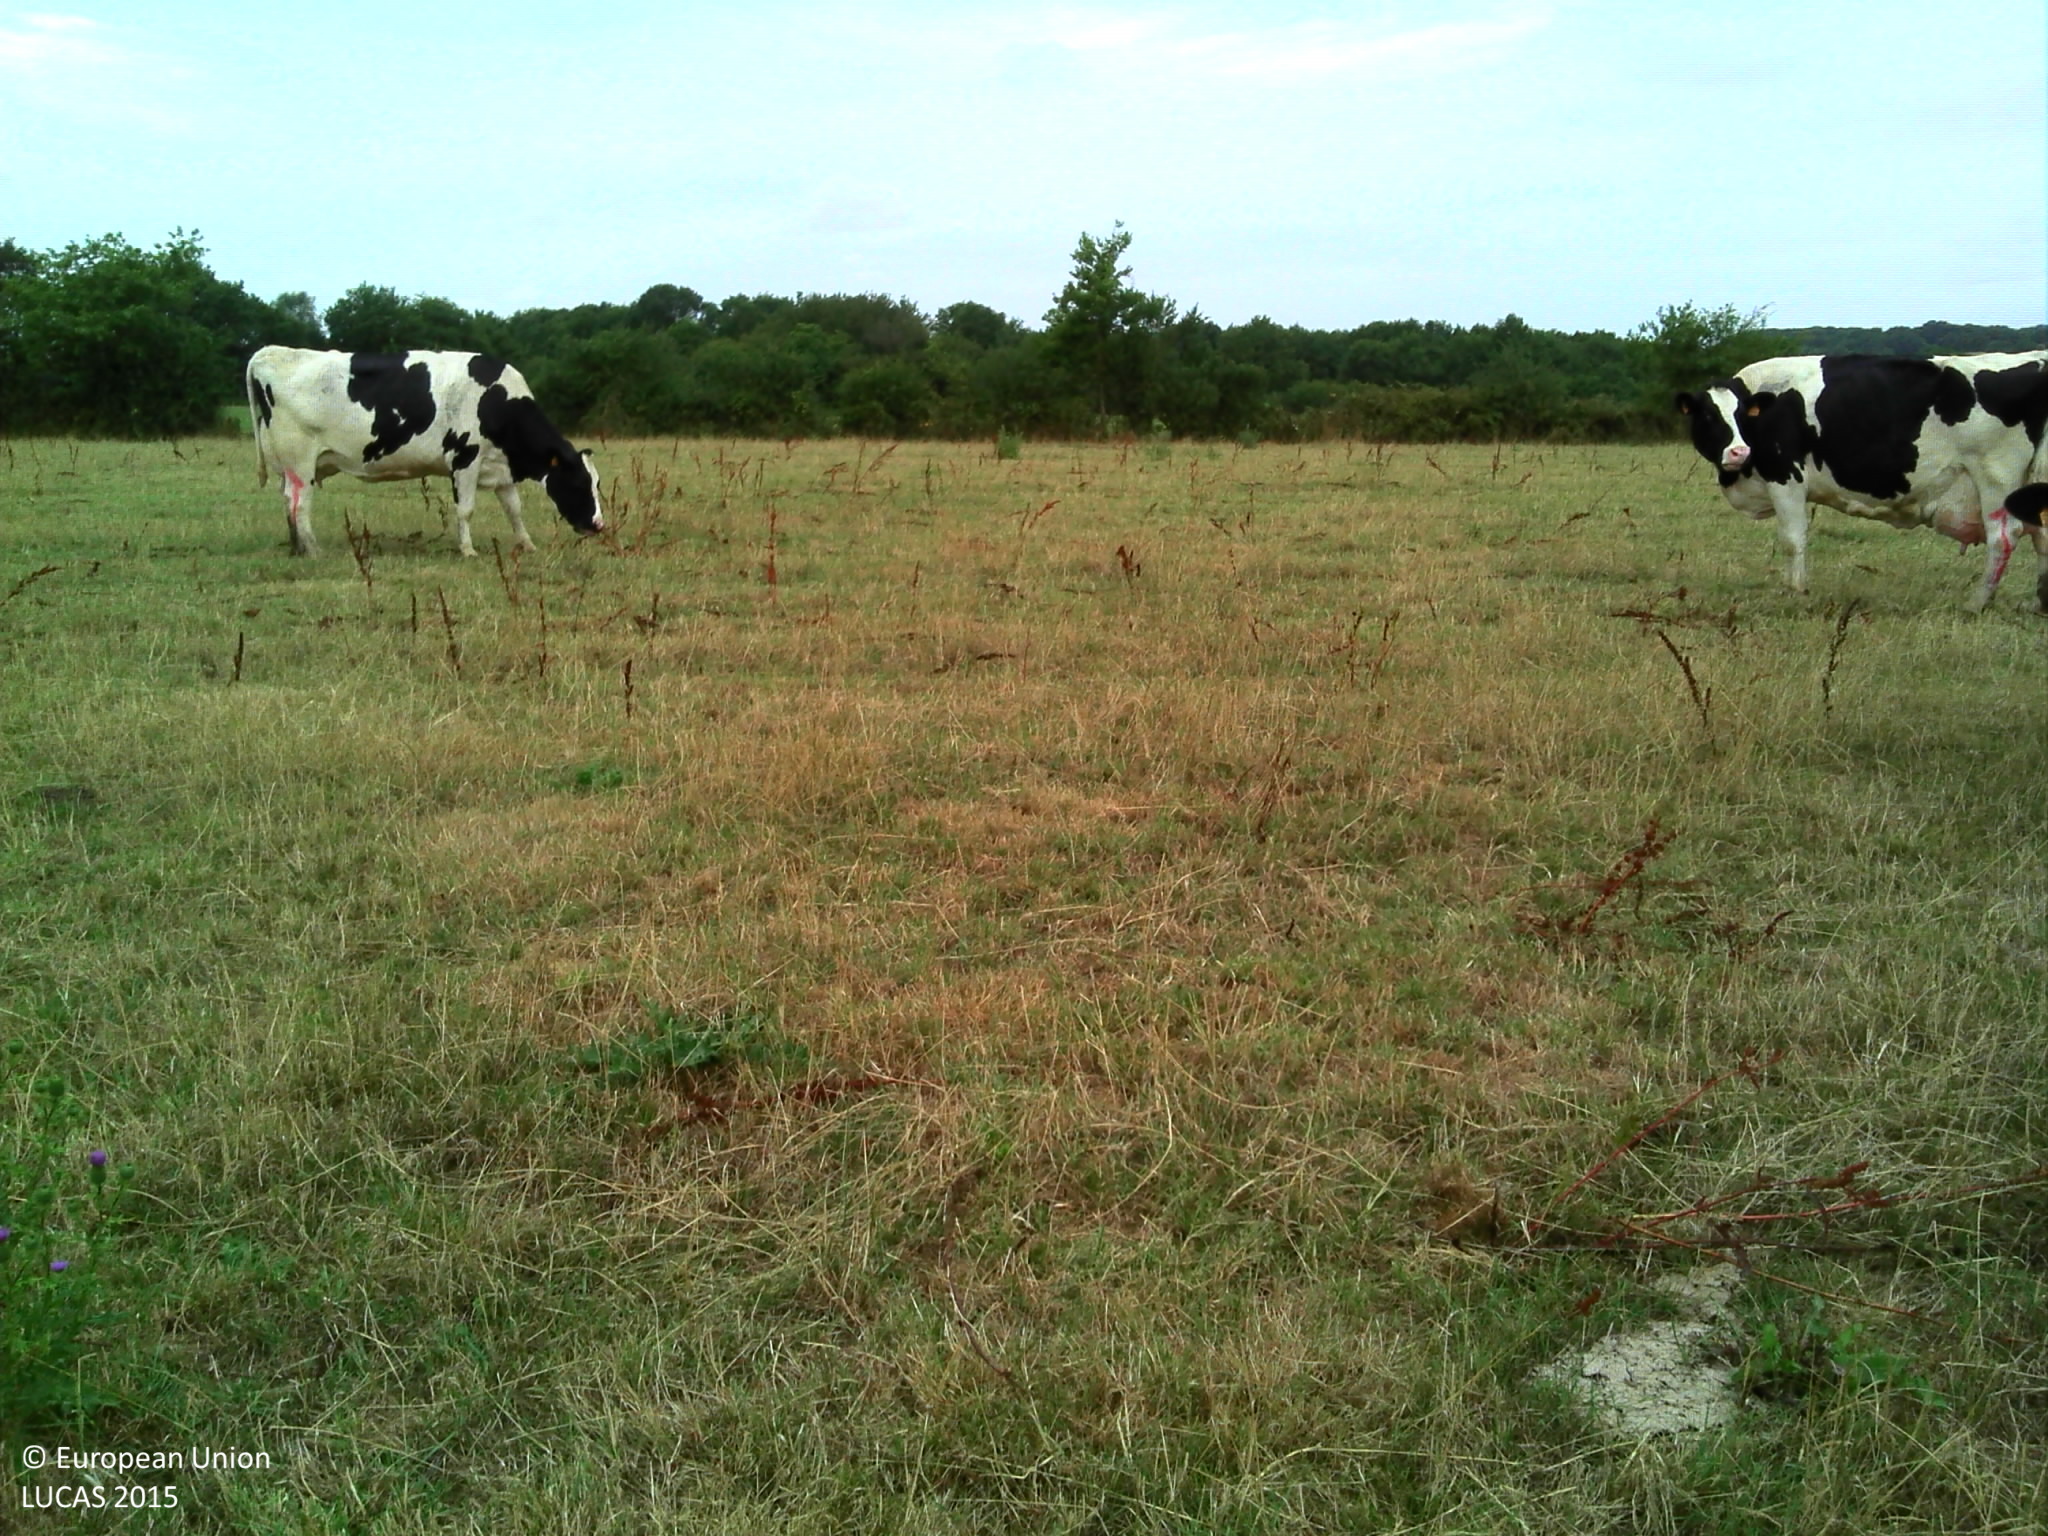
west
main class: Cropland
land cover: Temporary grasslands
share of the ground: > 75 %
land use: Agriculture (excluding fallow land and kitchen gardens)
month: July
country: FR
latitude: 47.7233
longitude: -1.5497
